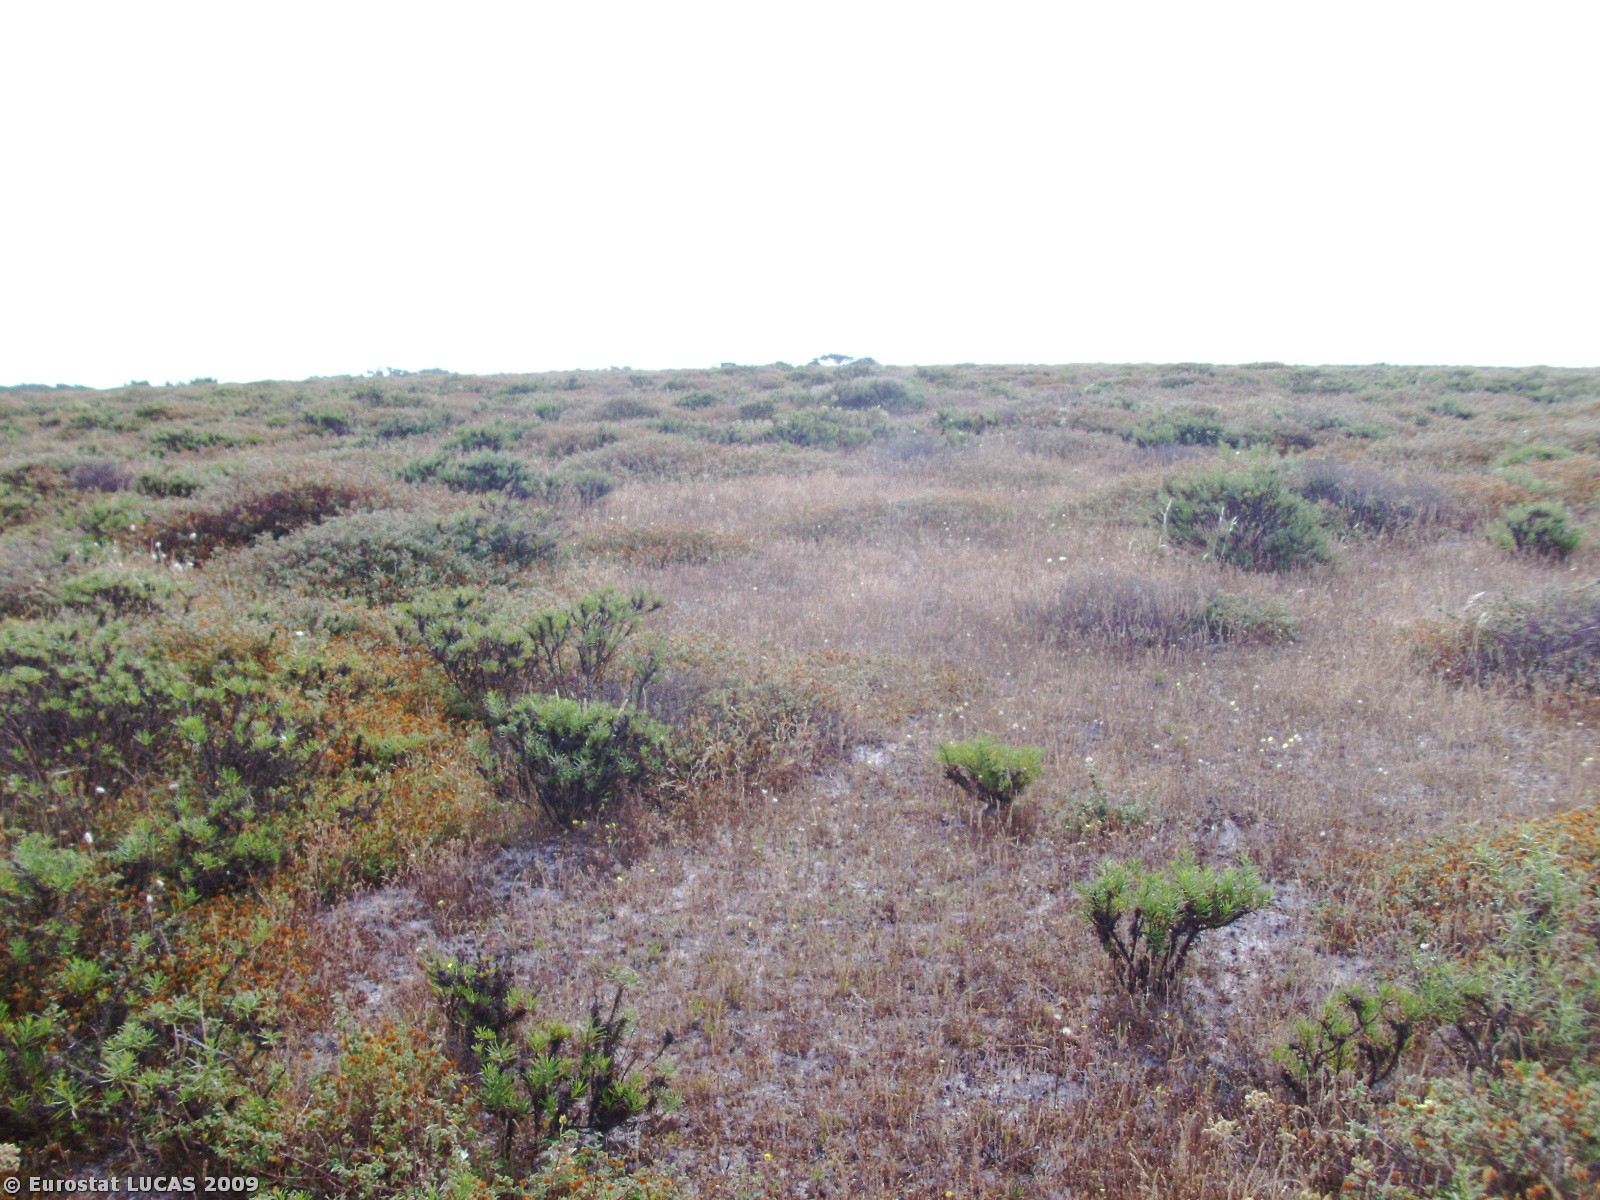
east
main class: Shrubland
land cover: Shrubland without tree cover
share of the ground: > 75 %
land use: Nature reserves
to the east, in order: Shrubland without tree cover; Tracks; Shrubland without tree cover
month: June
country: PT
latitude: 37.1125
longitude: -8.9065
